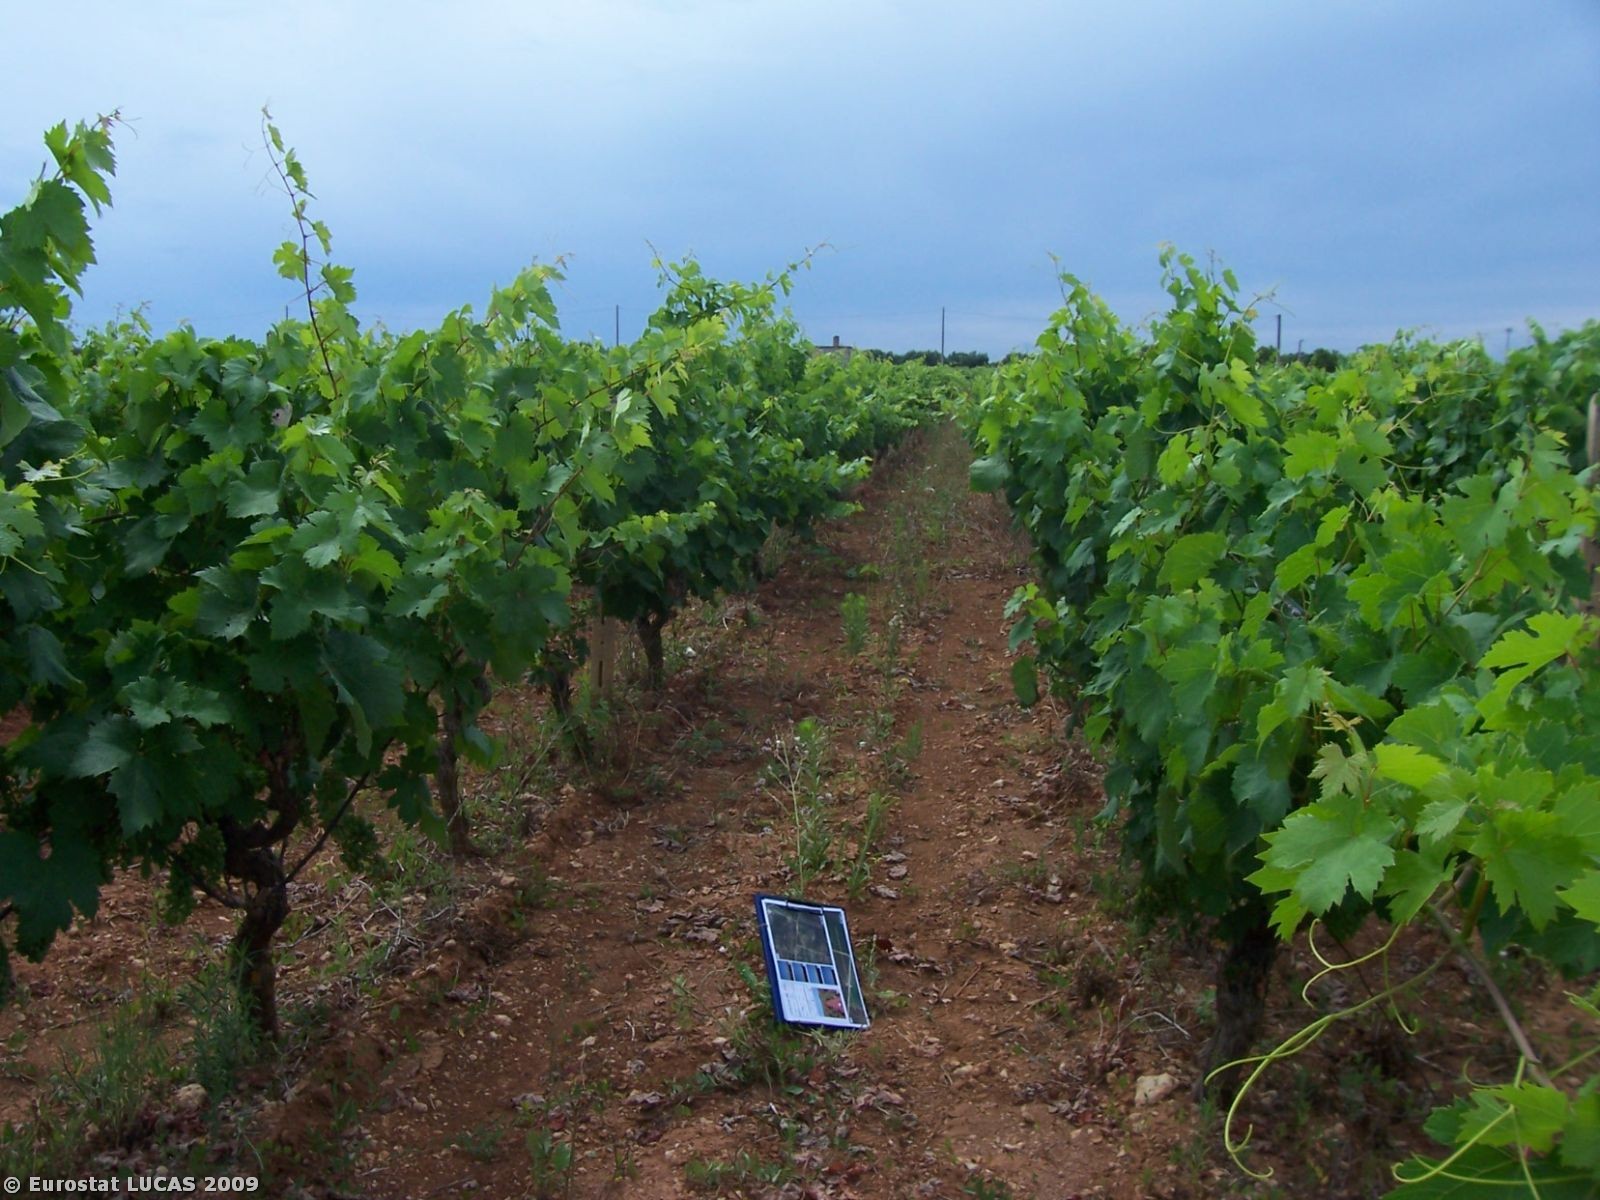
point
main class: Cropland
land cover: Vineyards
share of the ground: 25 - 50 %
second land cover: Bare land
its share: > 75 %
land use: Agriculture (excluding fallow land and kitchen gardens)
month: June
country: IT
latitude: 40.3417
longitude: 17.5207
